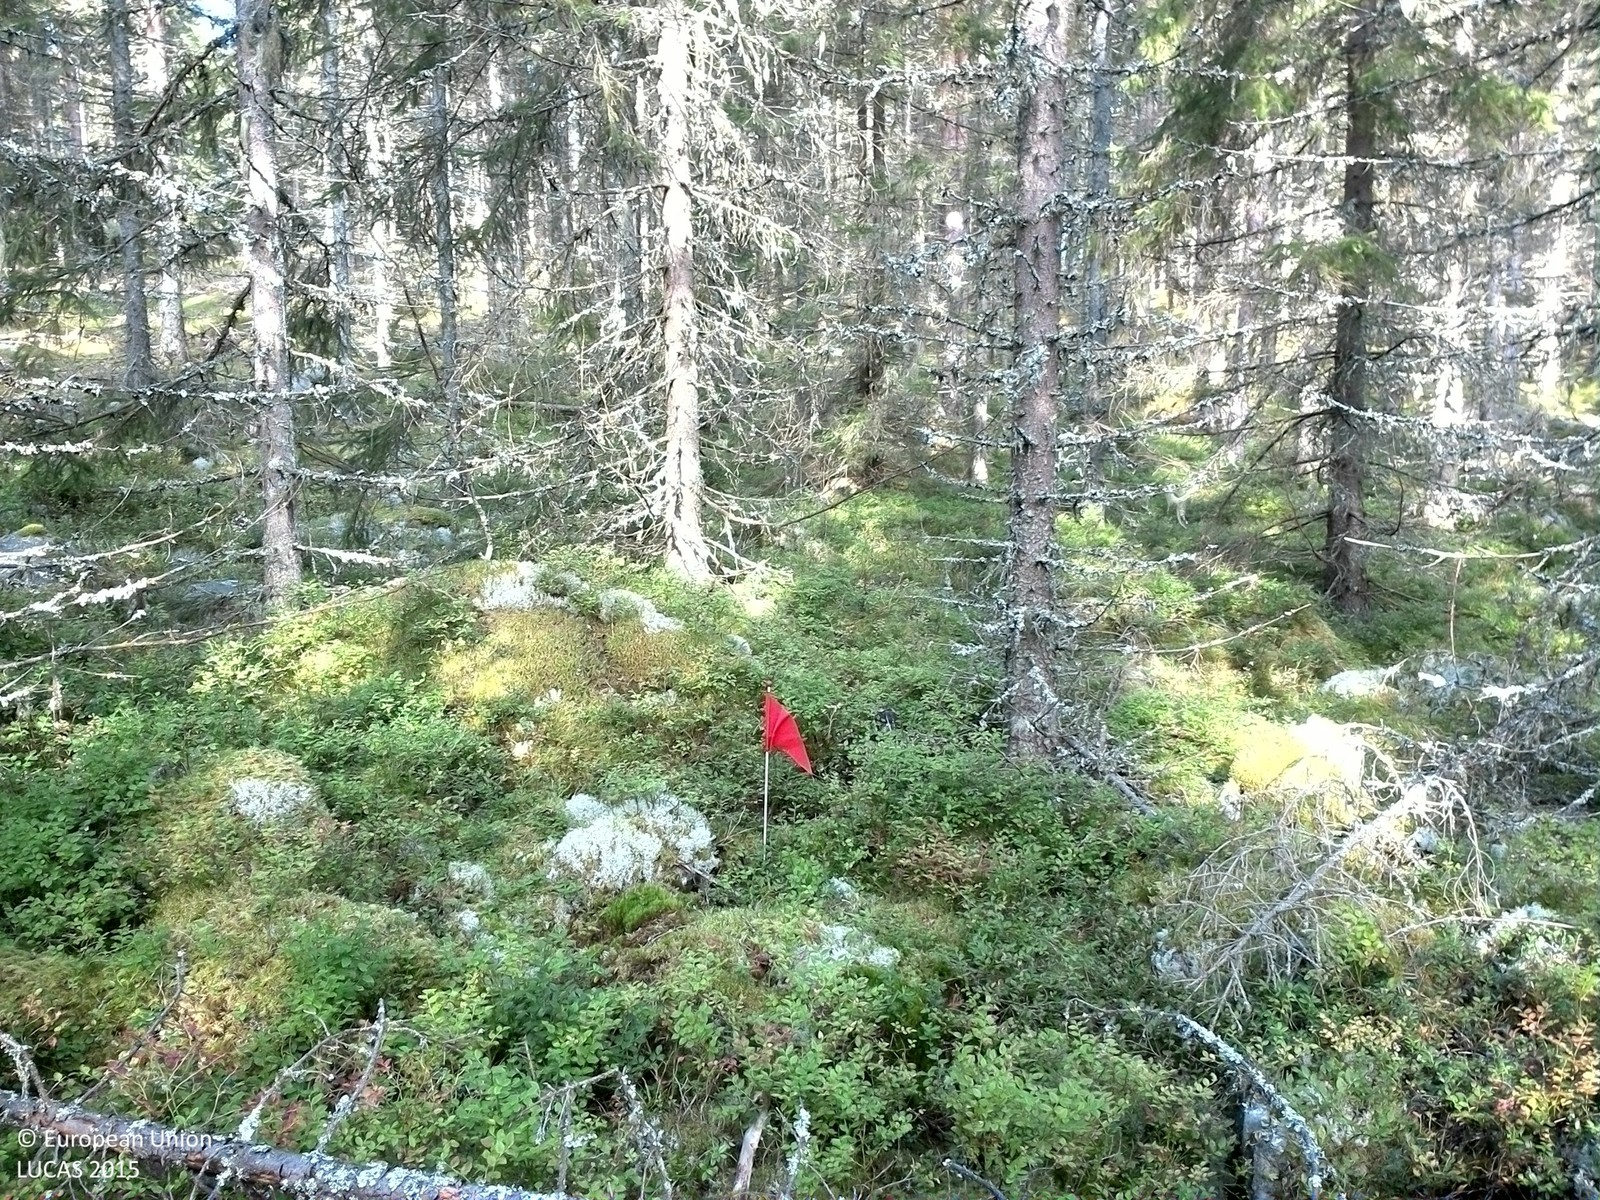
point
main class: Woodland
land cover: Spruce dominated coniferous woodland
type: boreal forest
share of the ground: 50 - 75 %
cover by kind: coniferous forest trees 70 %, shrubs 15 %, lichens and mosses 15 %
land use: Forestry
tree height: > 5 m
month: September
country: SE
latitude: 59.9395
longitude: 13.4810
